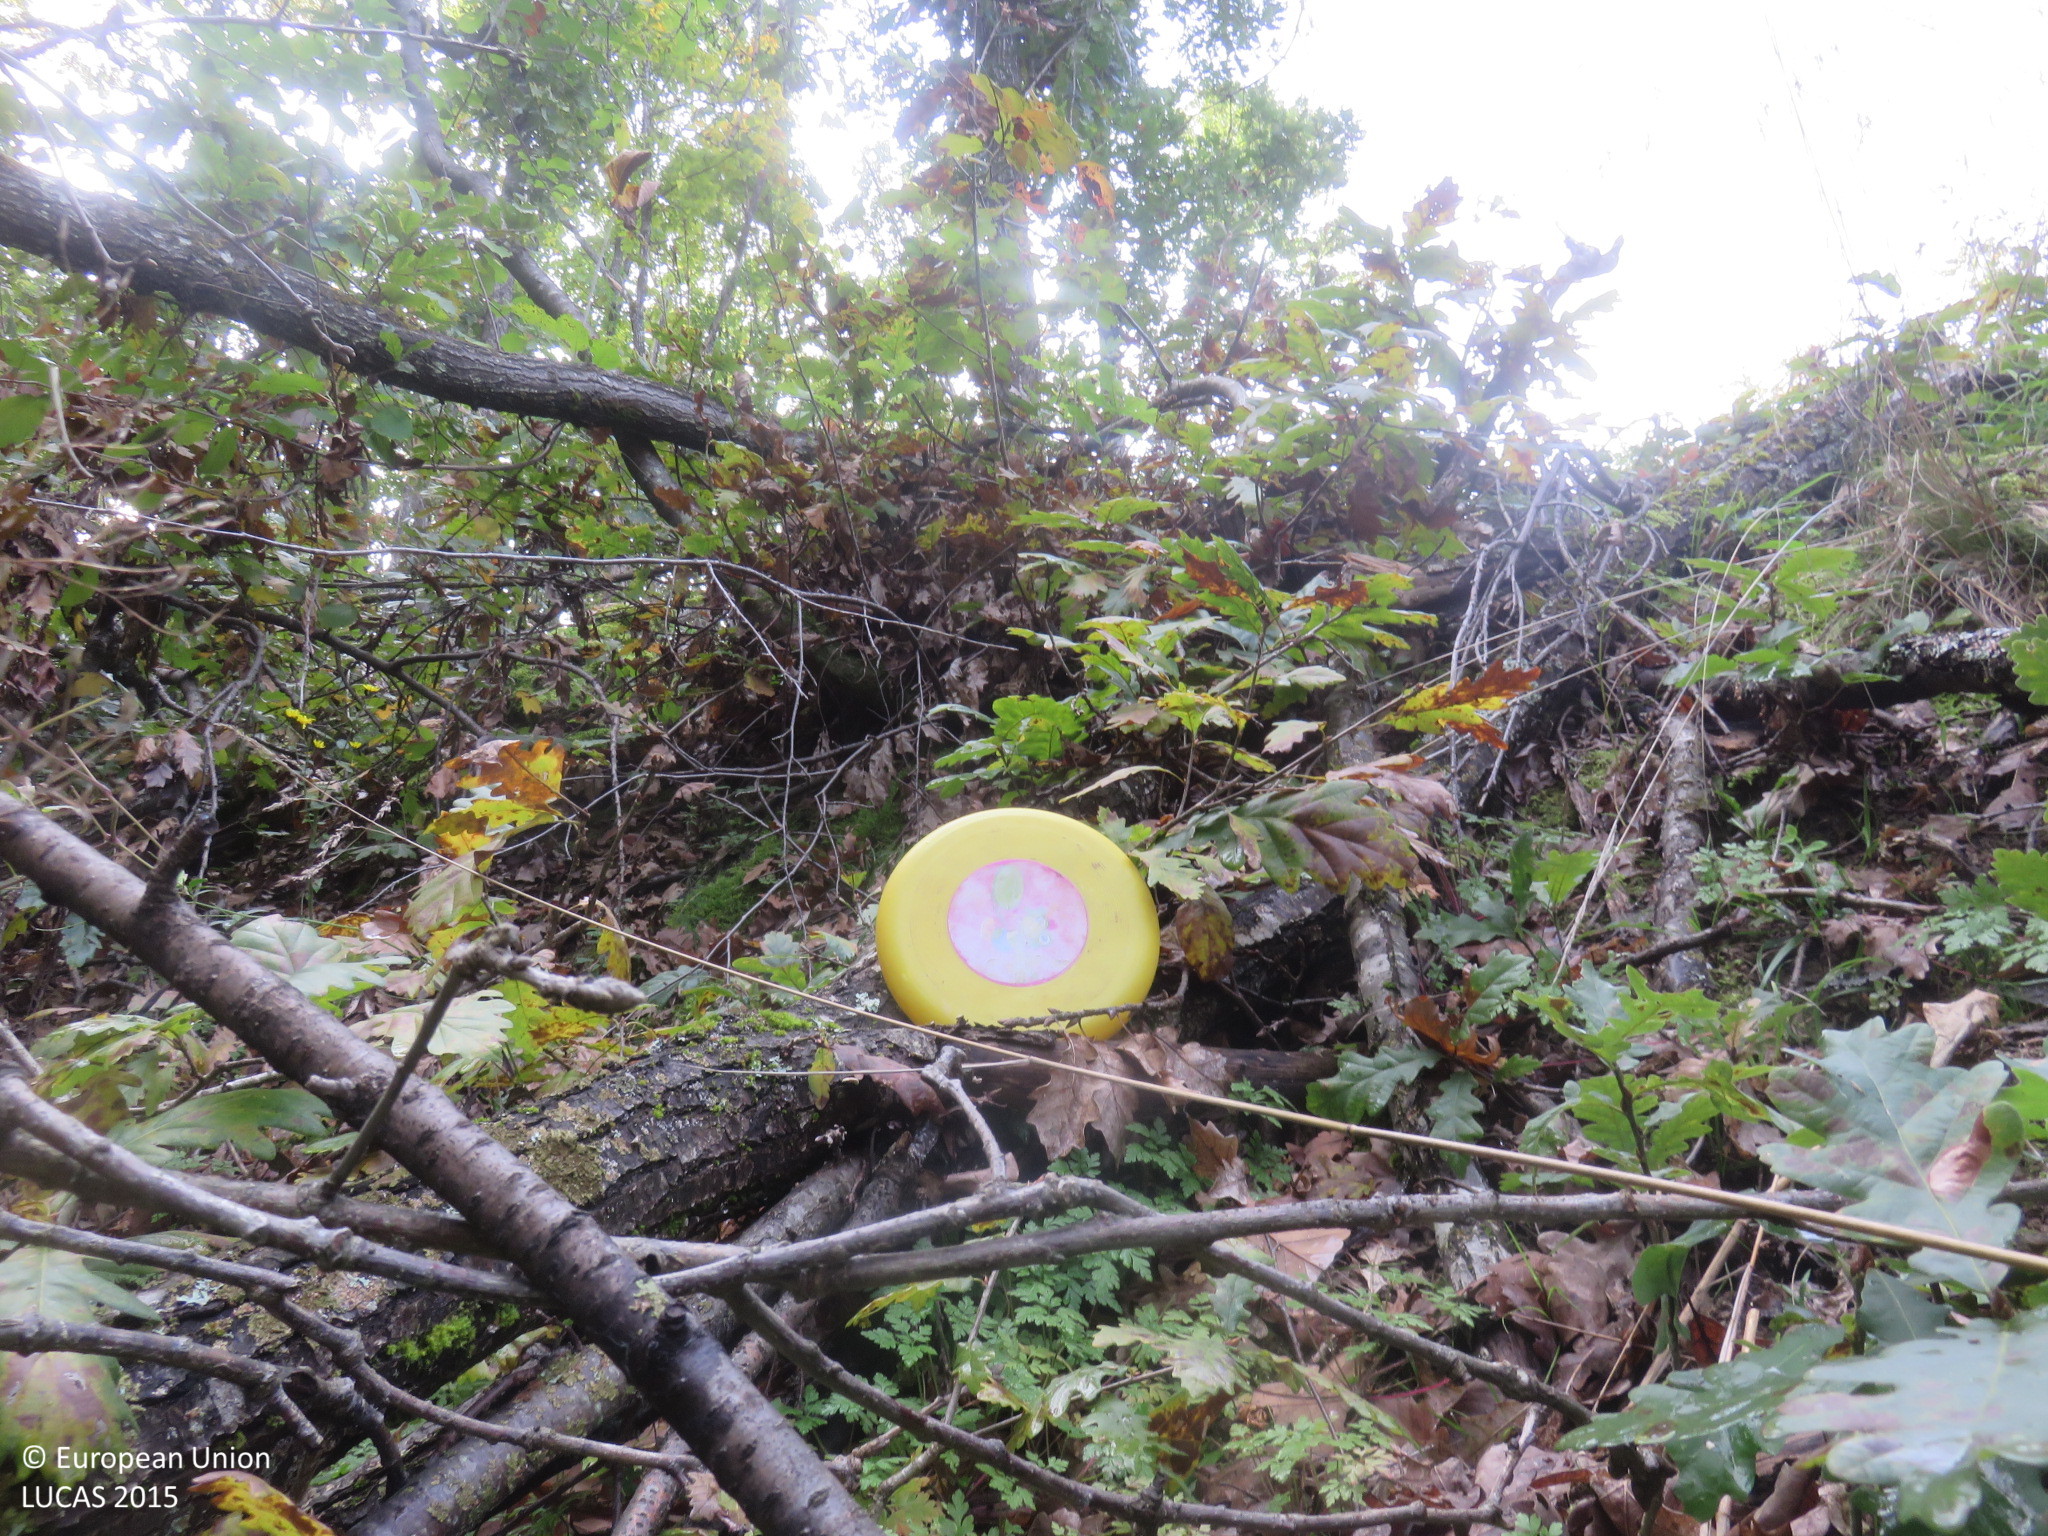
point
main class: Woodland
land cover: Broadleaved woodland
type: mesophytic deciduous forest
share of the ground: > 75 %
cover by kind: broadleaved forest trees 90 %, herbaceous plants 5 %, unconsolidated bare surface 5 %
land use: Forestry
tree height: < 5 m
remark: Clear cut
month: October
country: BG
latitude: 42.9231
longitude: 24.9995
